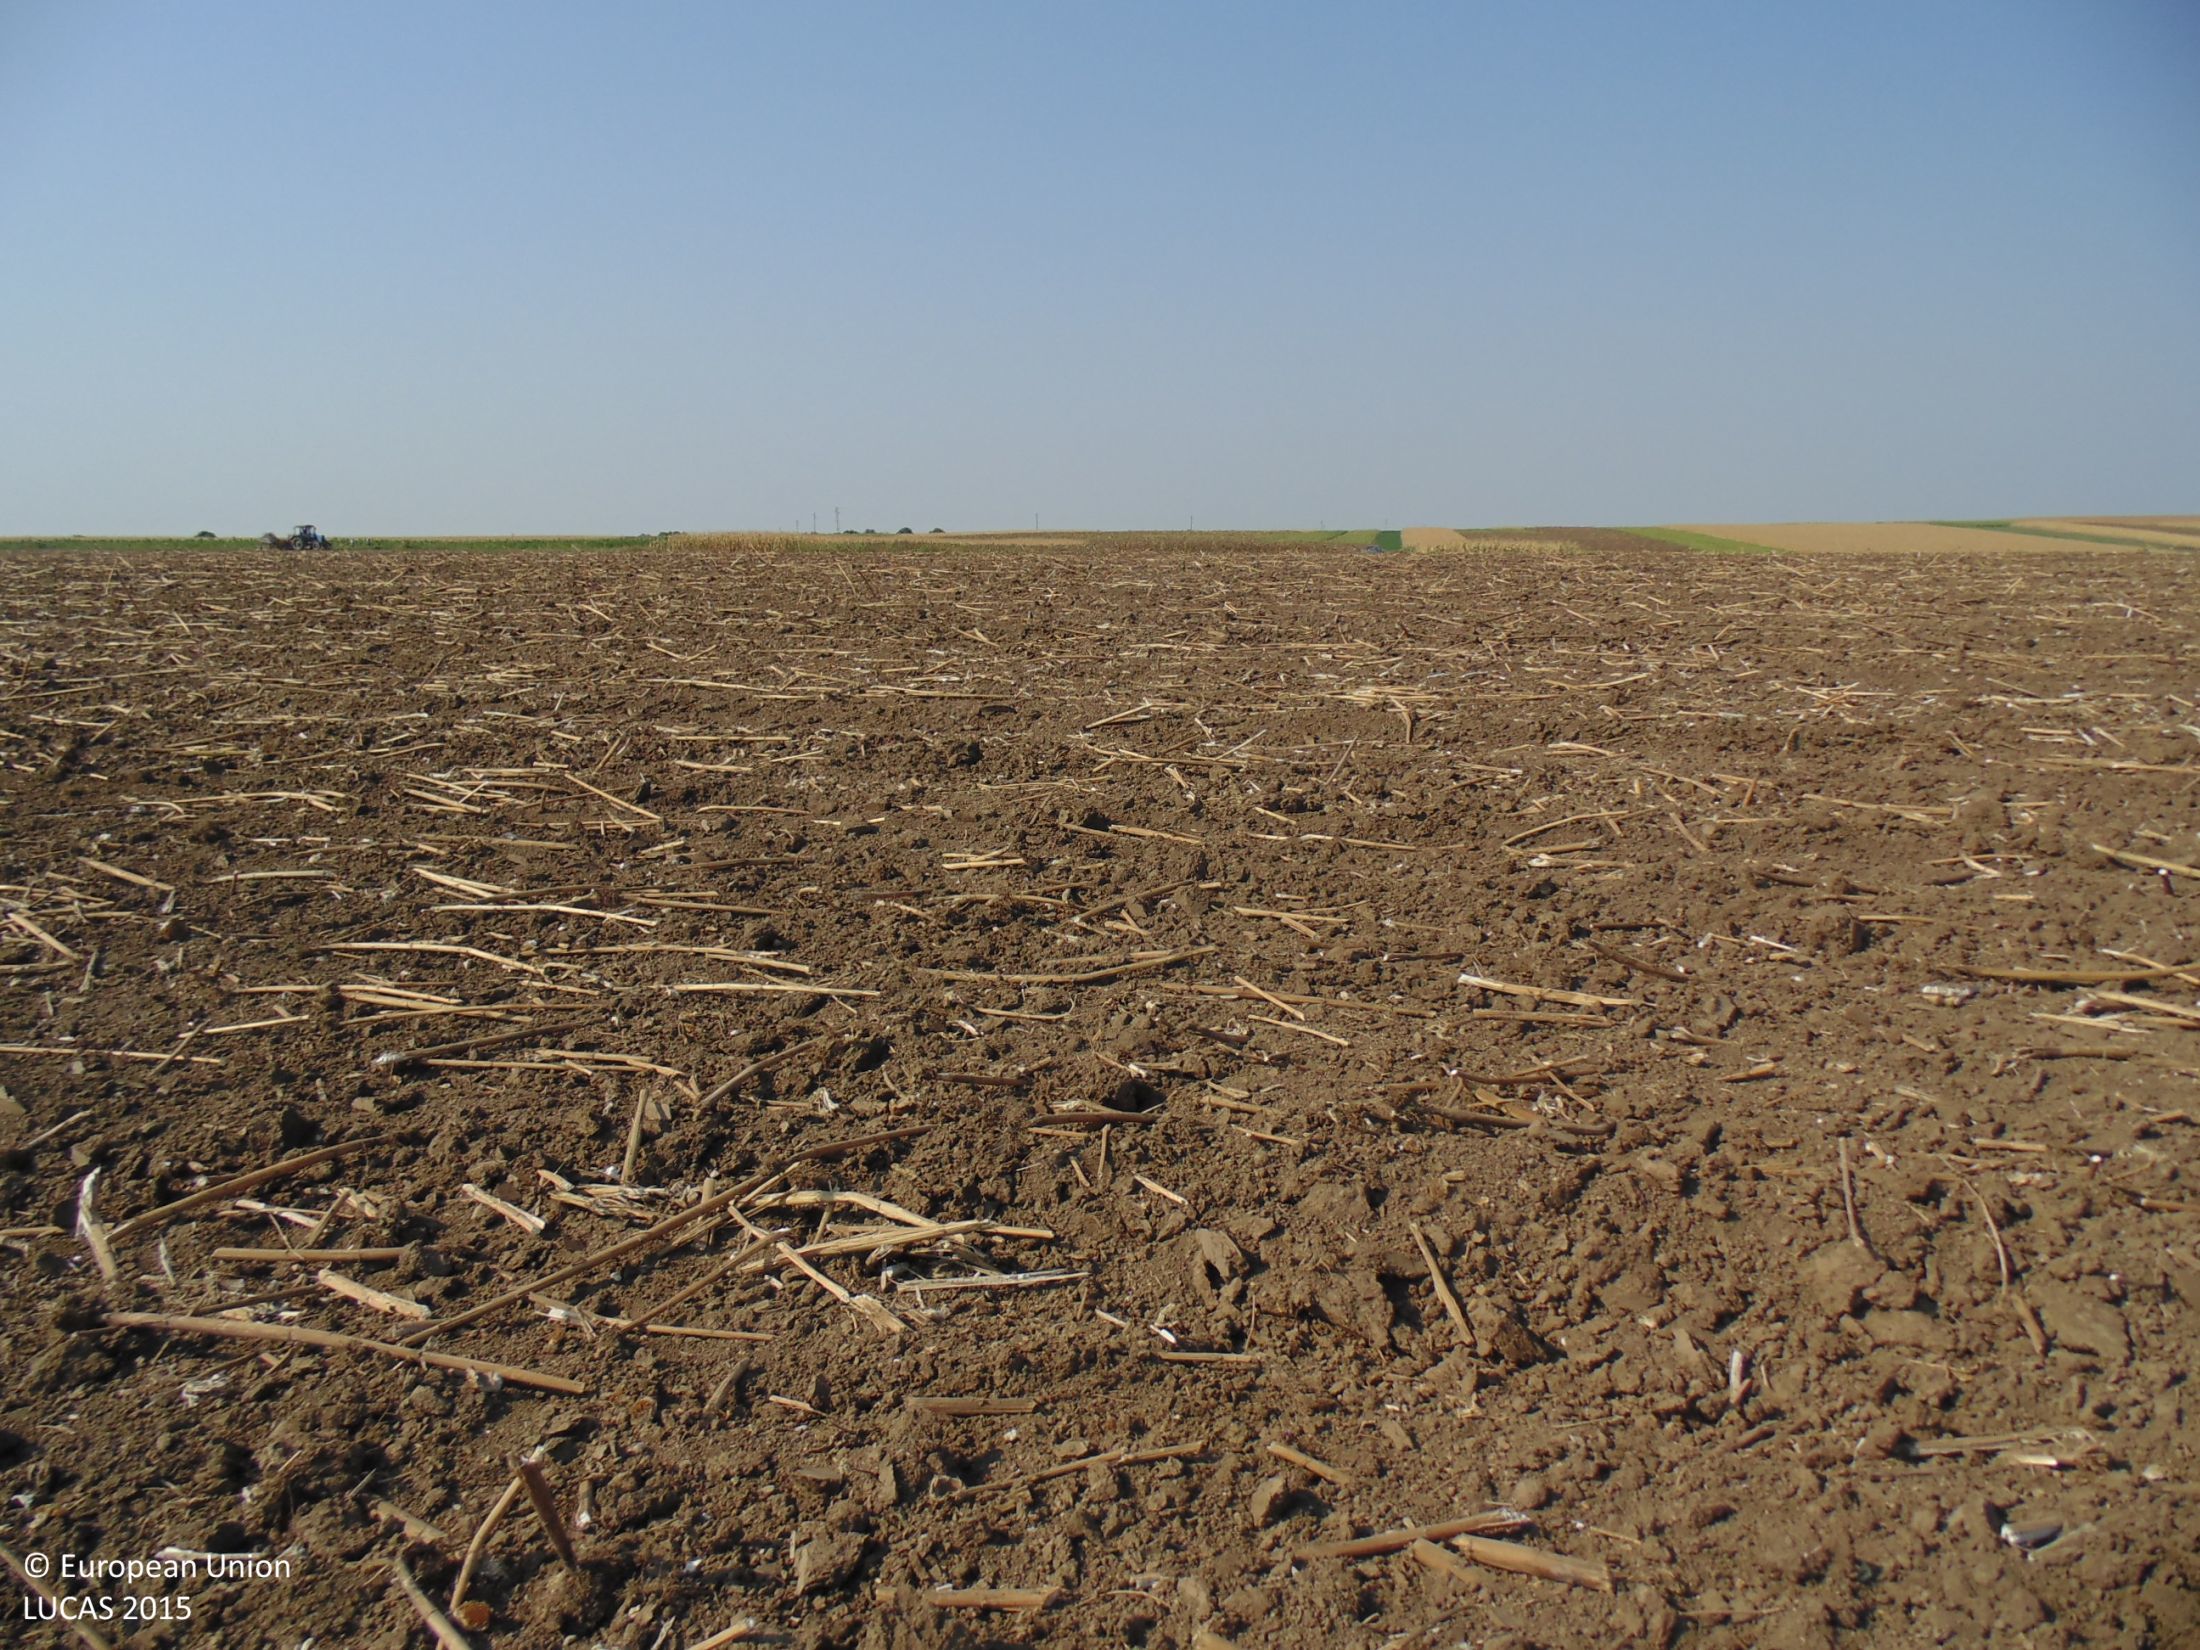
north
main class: Cropland
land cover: Sunflower
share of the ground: < 10 %
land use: Agriculture (excluding fallow land and kitchen gardens)
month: September
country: BG
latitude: 43.8009
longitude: 26.8852
